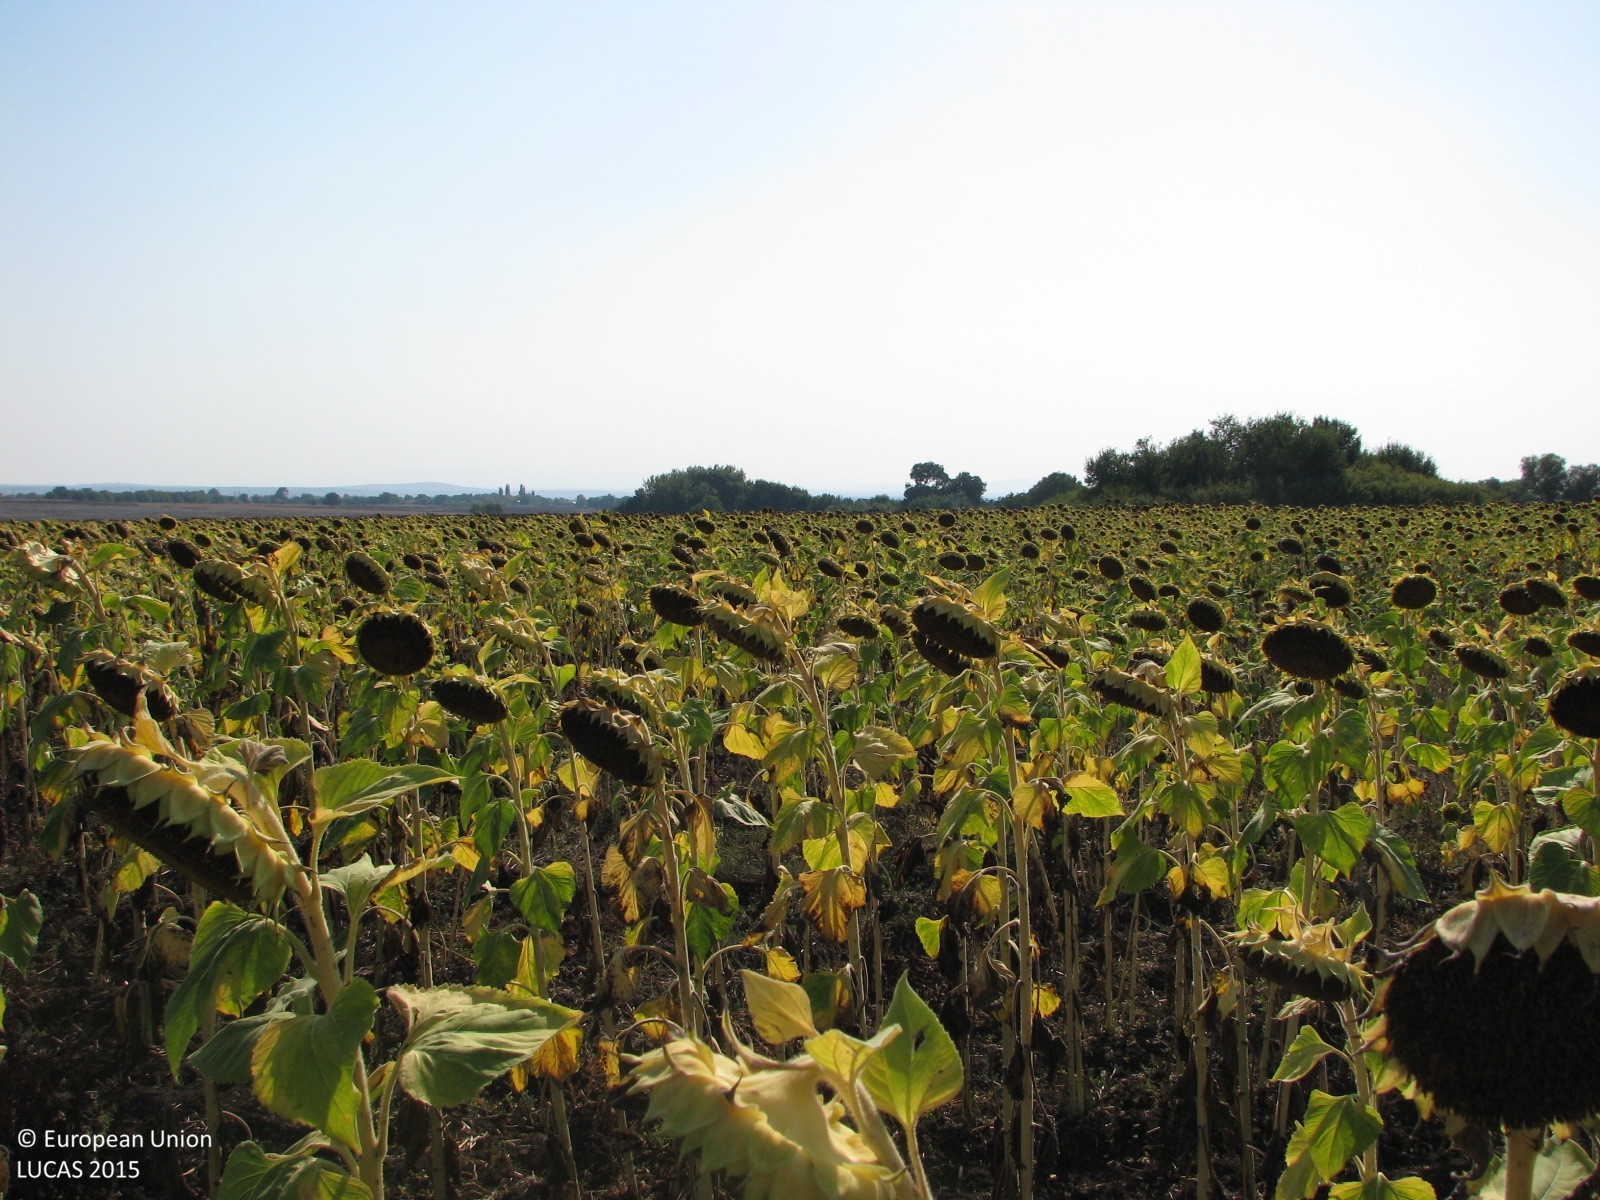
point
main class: Cropland
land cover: Sunflower
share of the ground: > 75 %
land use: Agriculture (excluding fallow land and kitchen gardens)
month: September
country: BG
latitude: 42.3749
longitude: 26.7216
